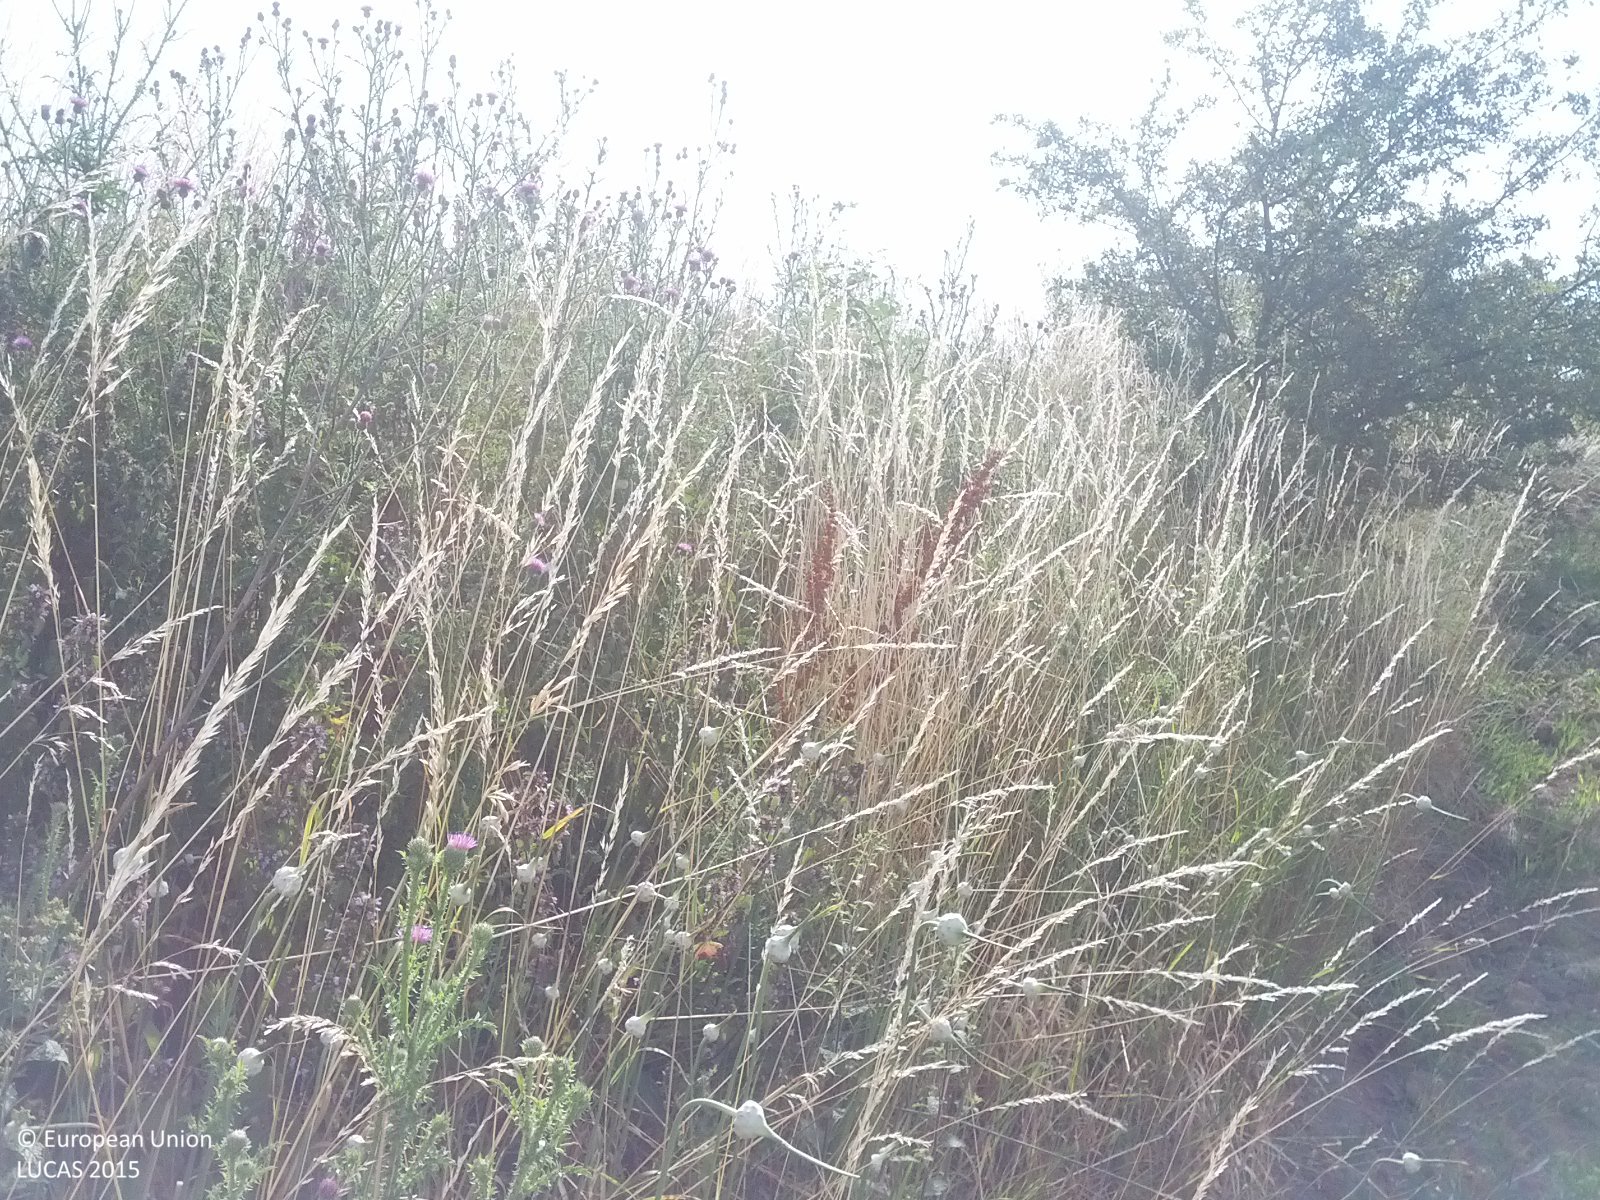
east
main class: Grassland
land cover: Grassland without tree/shrub cover
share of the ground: > 75 %
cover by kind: herbaceous plants 100 %
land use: Agriculture (excluding fallow land and kitchen gardens)
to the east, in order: Grassland without tree/shrub cover; Temporary grasslands; Grass margins; Tracks; Grass margins; Vineyards; Other bare soil; Vineyards
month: June
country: AT
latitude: 48.6890
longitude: 16.6769
